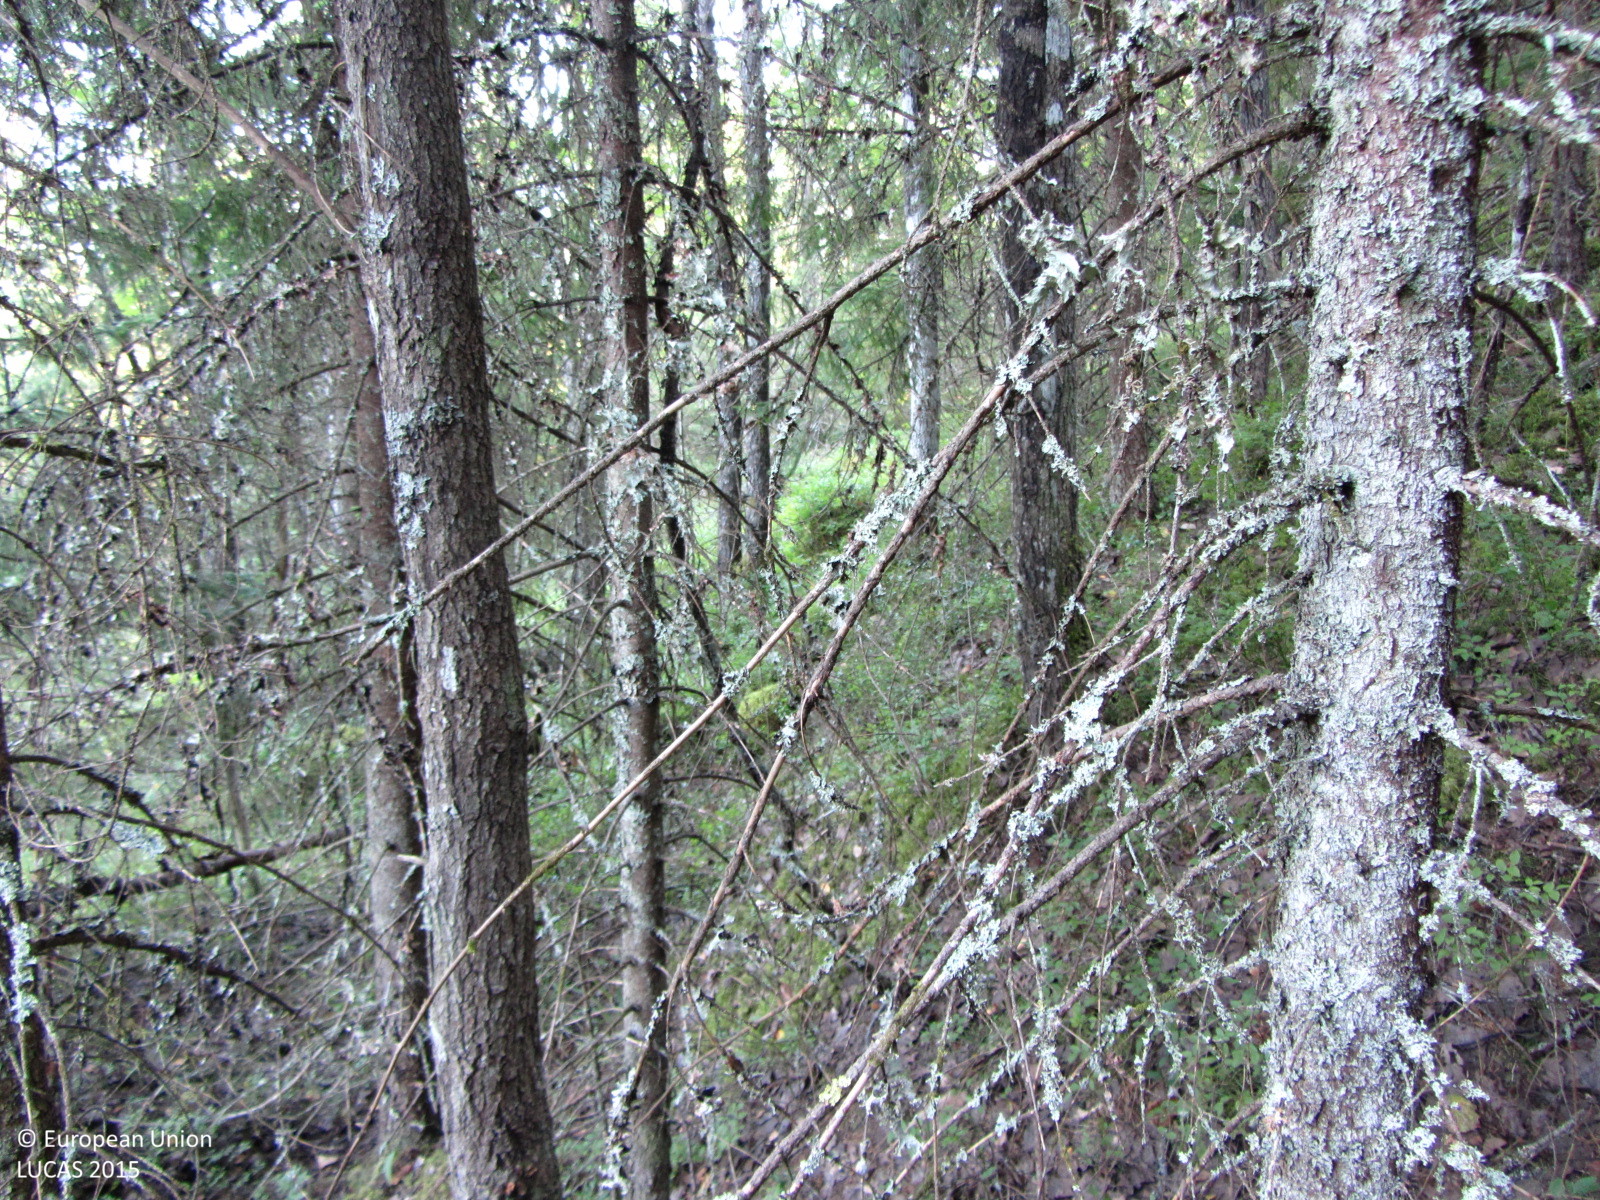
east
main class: Woodland
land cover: Spruce dominated mixed woodland
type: boreal forest
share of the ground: > 75 %
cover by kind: coniferous forest trees 50 %, broadleaved forest trees 30 %, shrubs 15 %, lichens and mosses 5 %
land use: Forestry
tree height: > 5 m
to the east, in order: Spruce dominated mixed woodland; Grassland with sparse tree/shrub cover; Tracks; Spruce dominated mixed woodland; Ditches and canals; Spruce dominated mixed woodland; Pine dominated mixed woodland
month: August
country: FI
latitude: 60.4419
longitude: 23.8876
